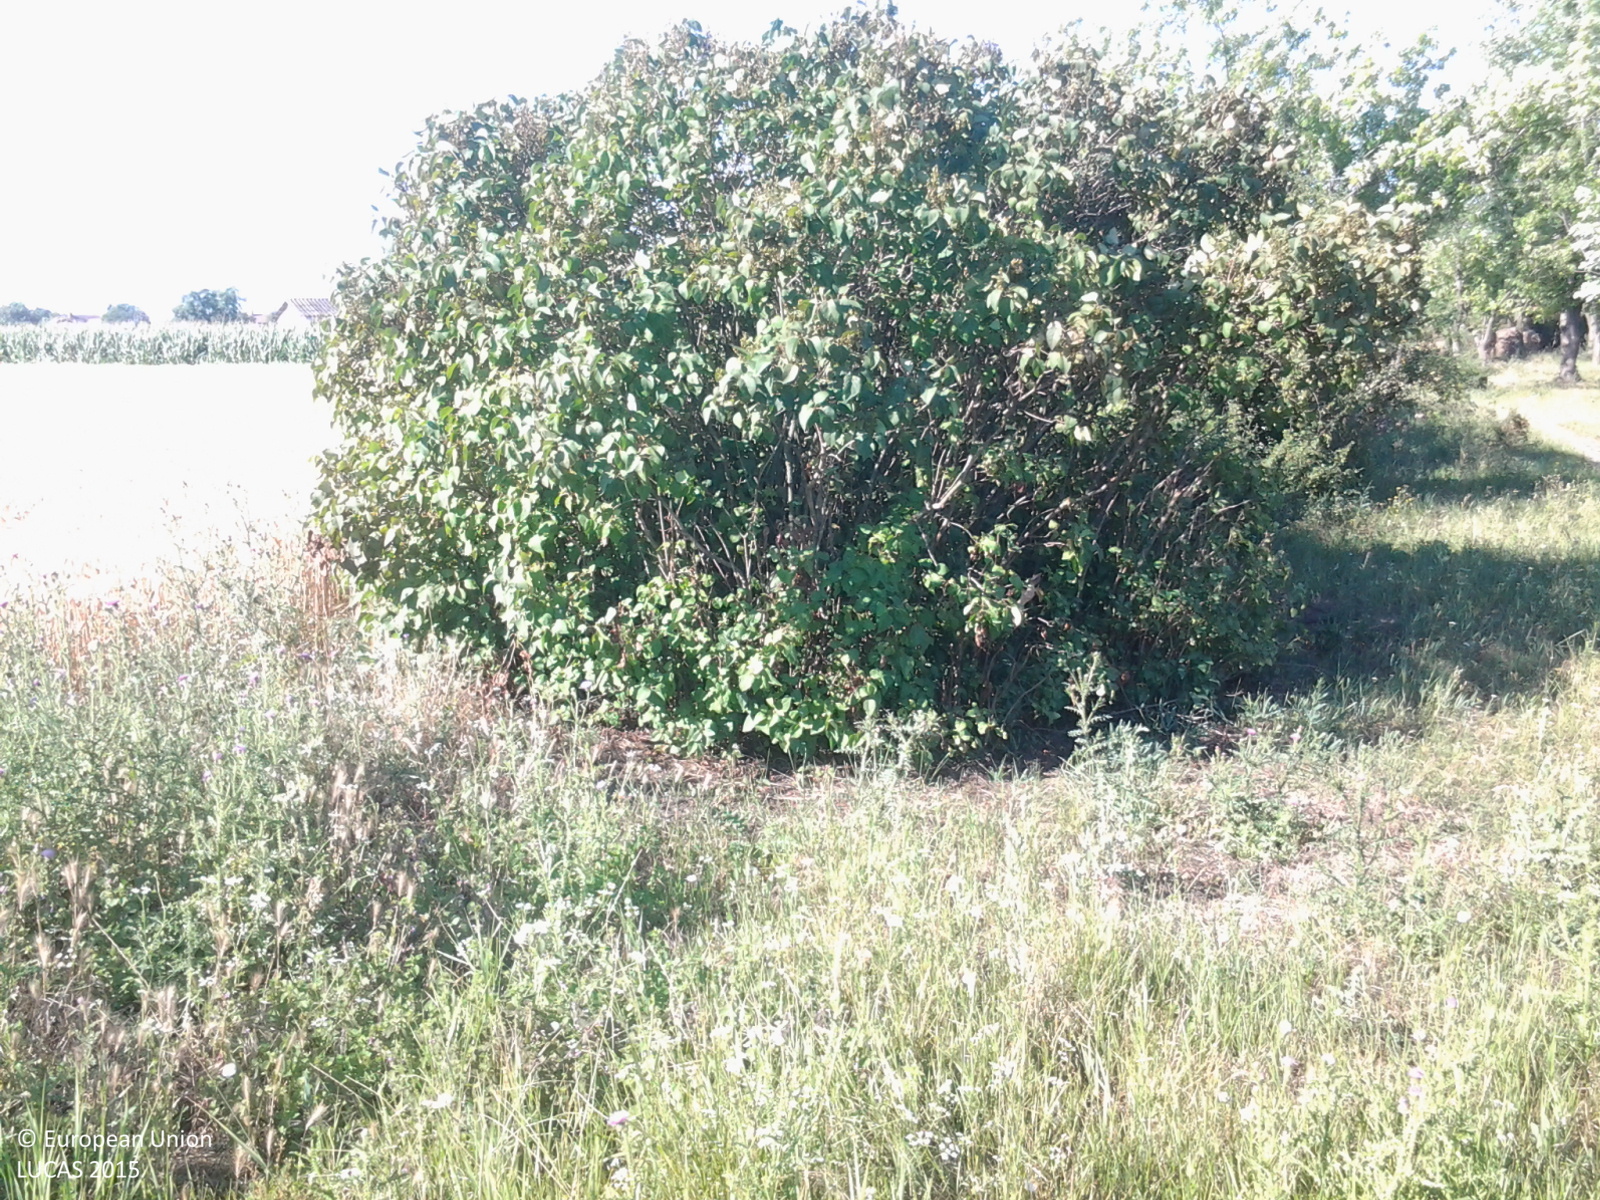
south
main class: Woodland
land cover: Broadleaved woodland
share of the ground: 10 - 25 %
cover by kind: herbaceous plants 75 %, broadleaved forest trees 15 %, shrubs 10 %
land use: Forestry
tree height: > 5 m
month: July
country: HU
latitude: 47.0702
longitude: 20.4714
